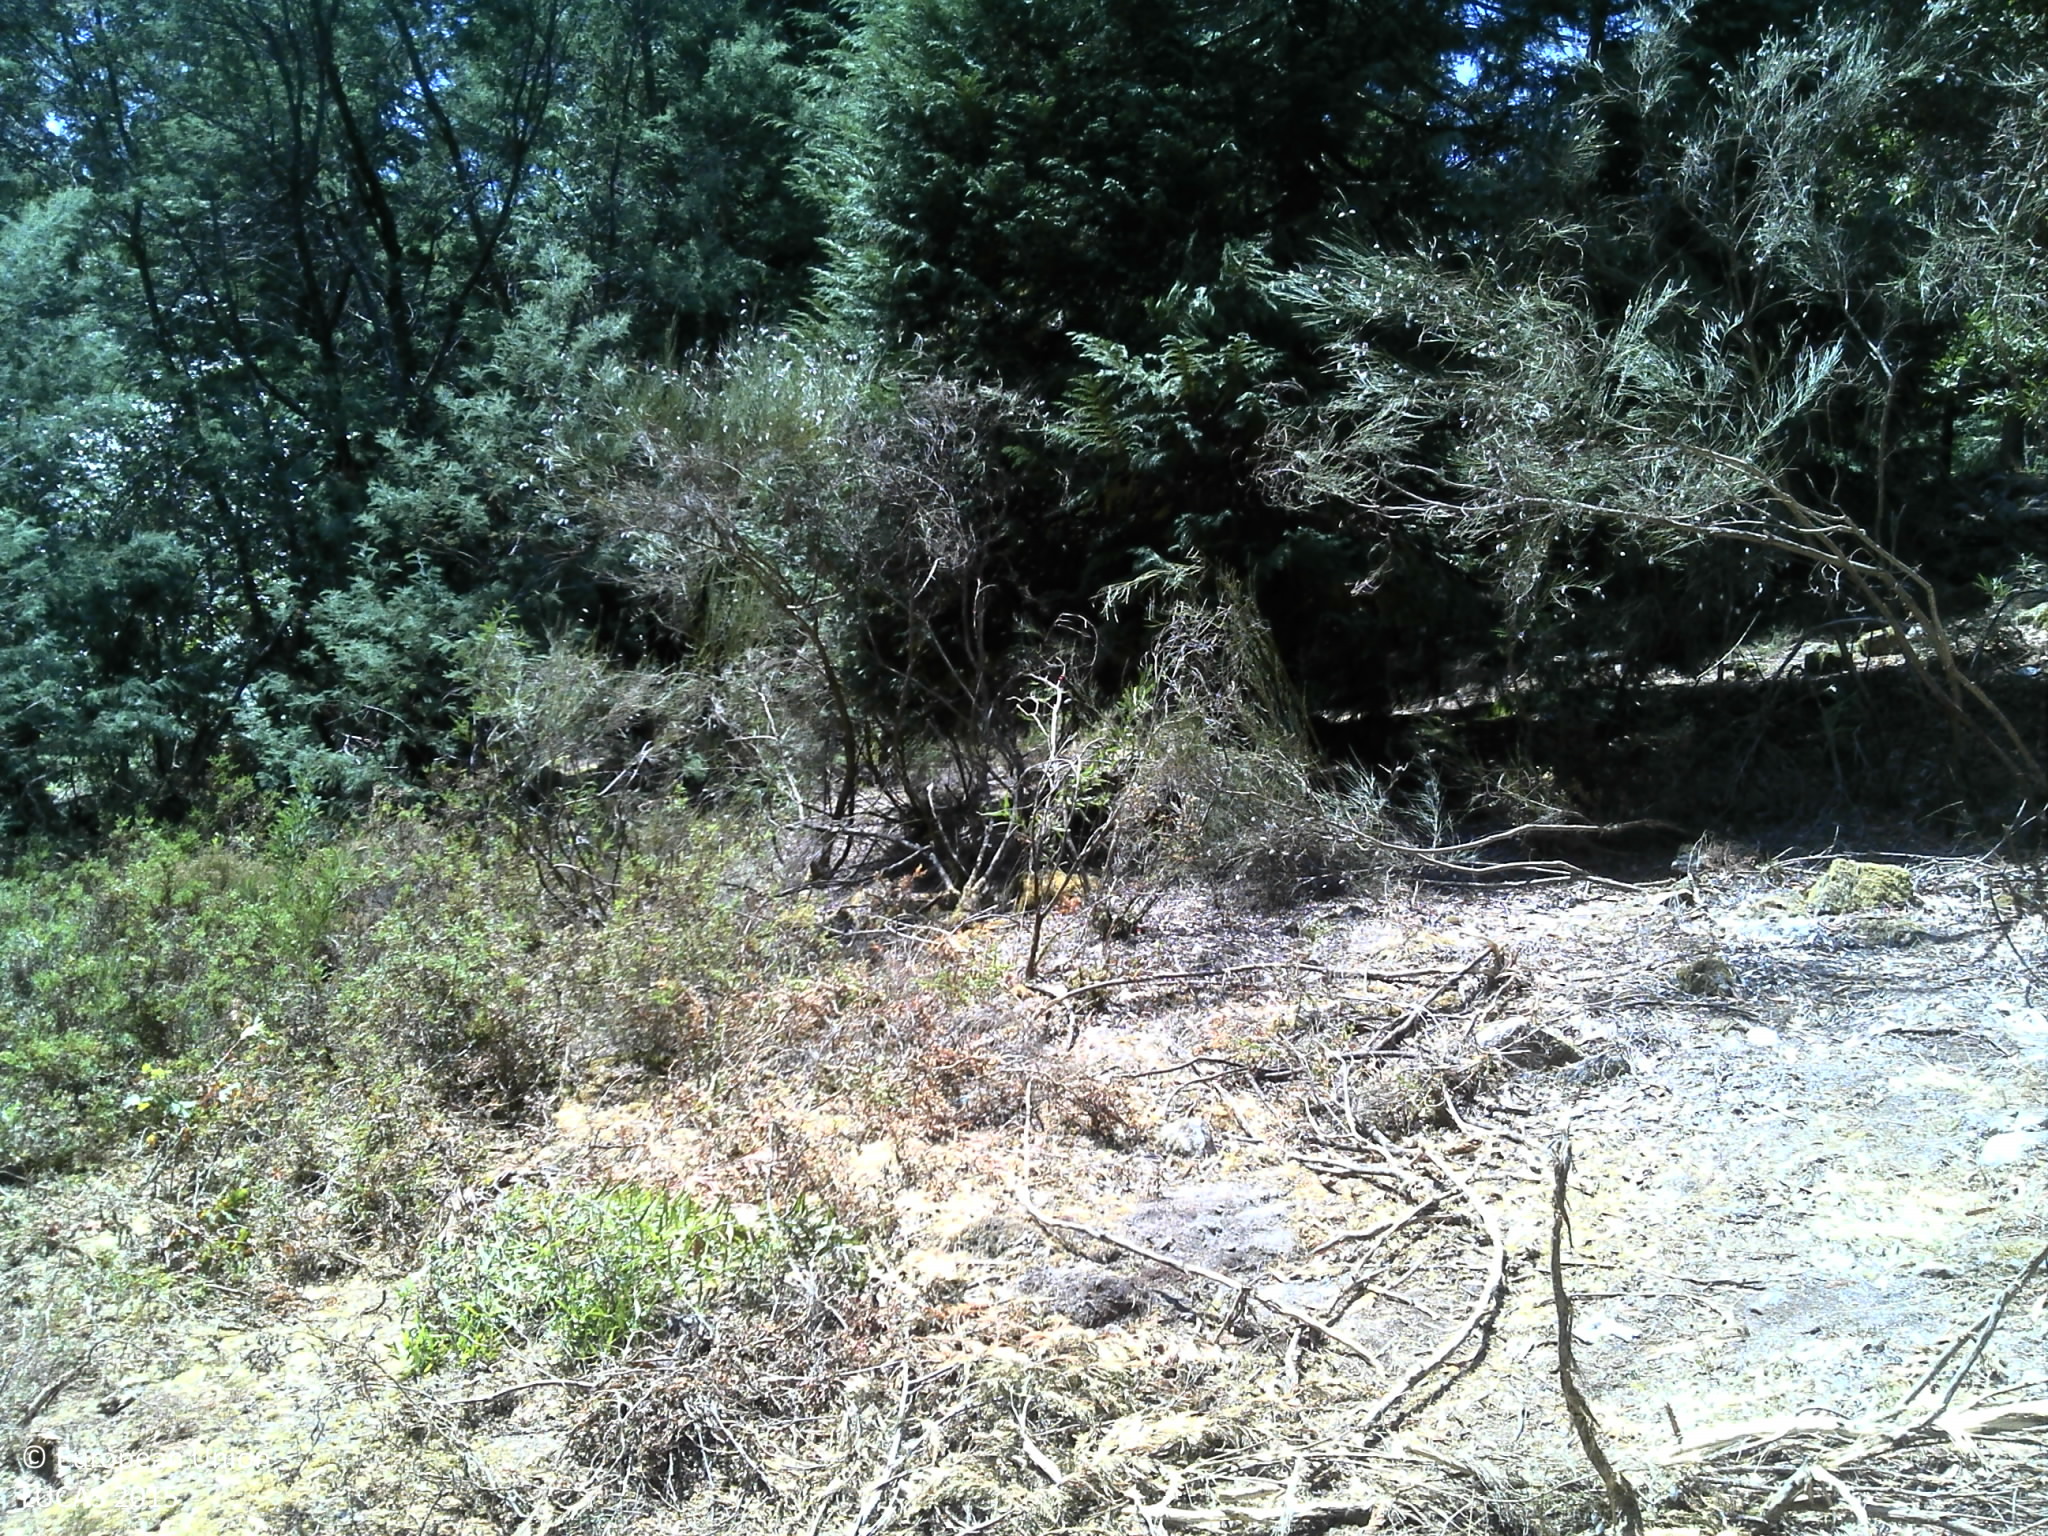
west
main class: Woodland
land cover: Other coniferous woodland
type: coniferous forest of the mediterranean region
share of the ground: 50 - 75 %
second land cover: Grassland without tree/shrub cover
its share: 25 - 50 %
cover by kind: coniferous forest trees 70 %, herbaceous plants 20 %, shrubs 5 %, unconsolidated bare surface 5 %
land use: Forestry
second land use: Agriculture (excluding fallow land and kitchen gardens)
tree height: > 5 m
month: July
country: PT
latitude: 41.6581
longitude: -8.0744
